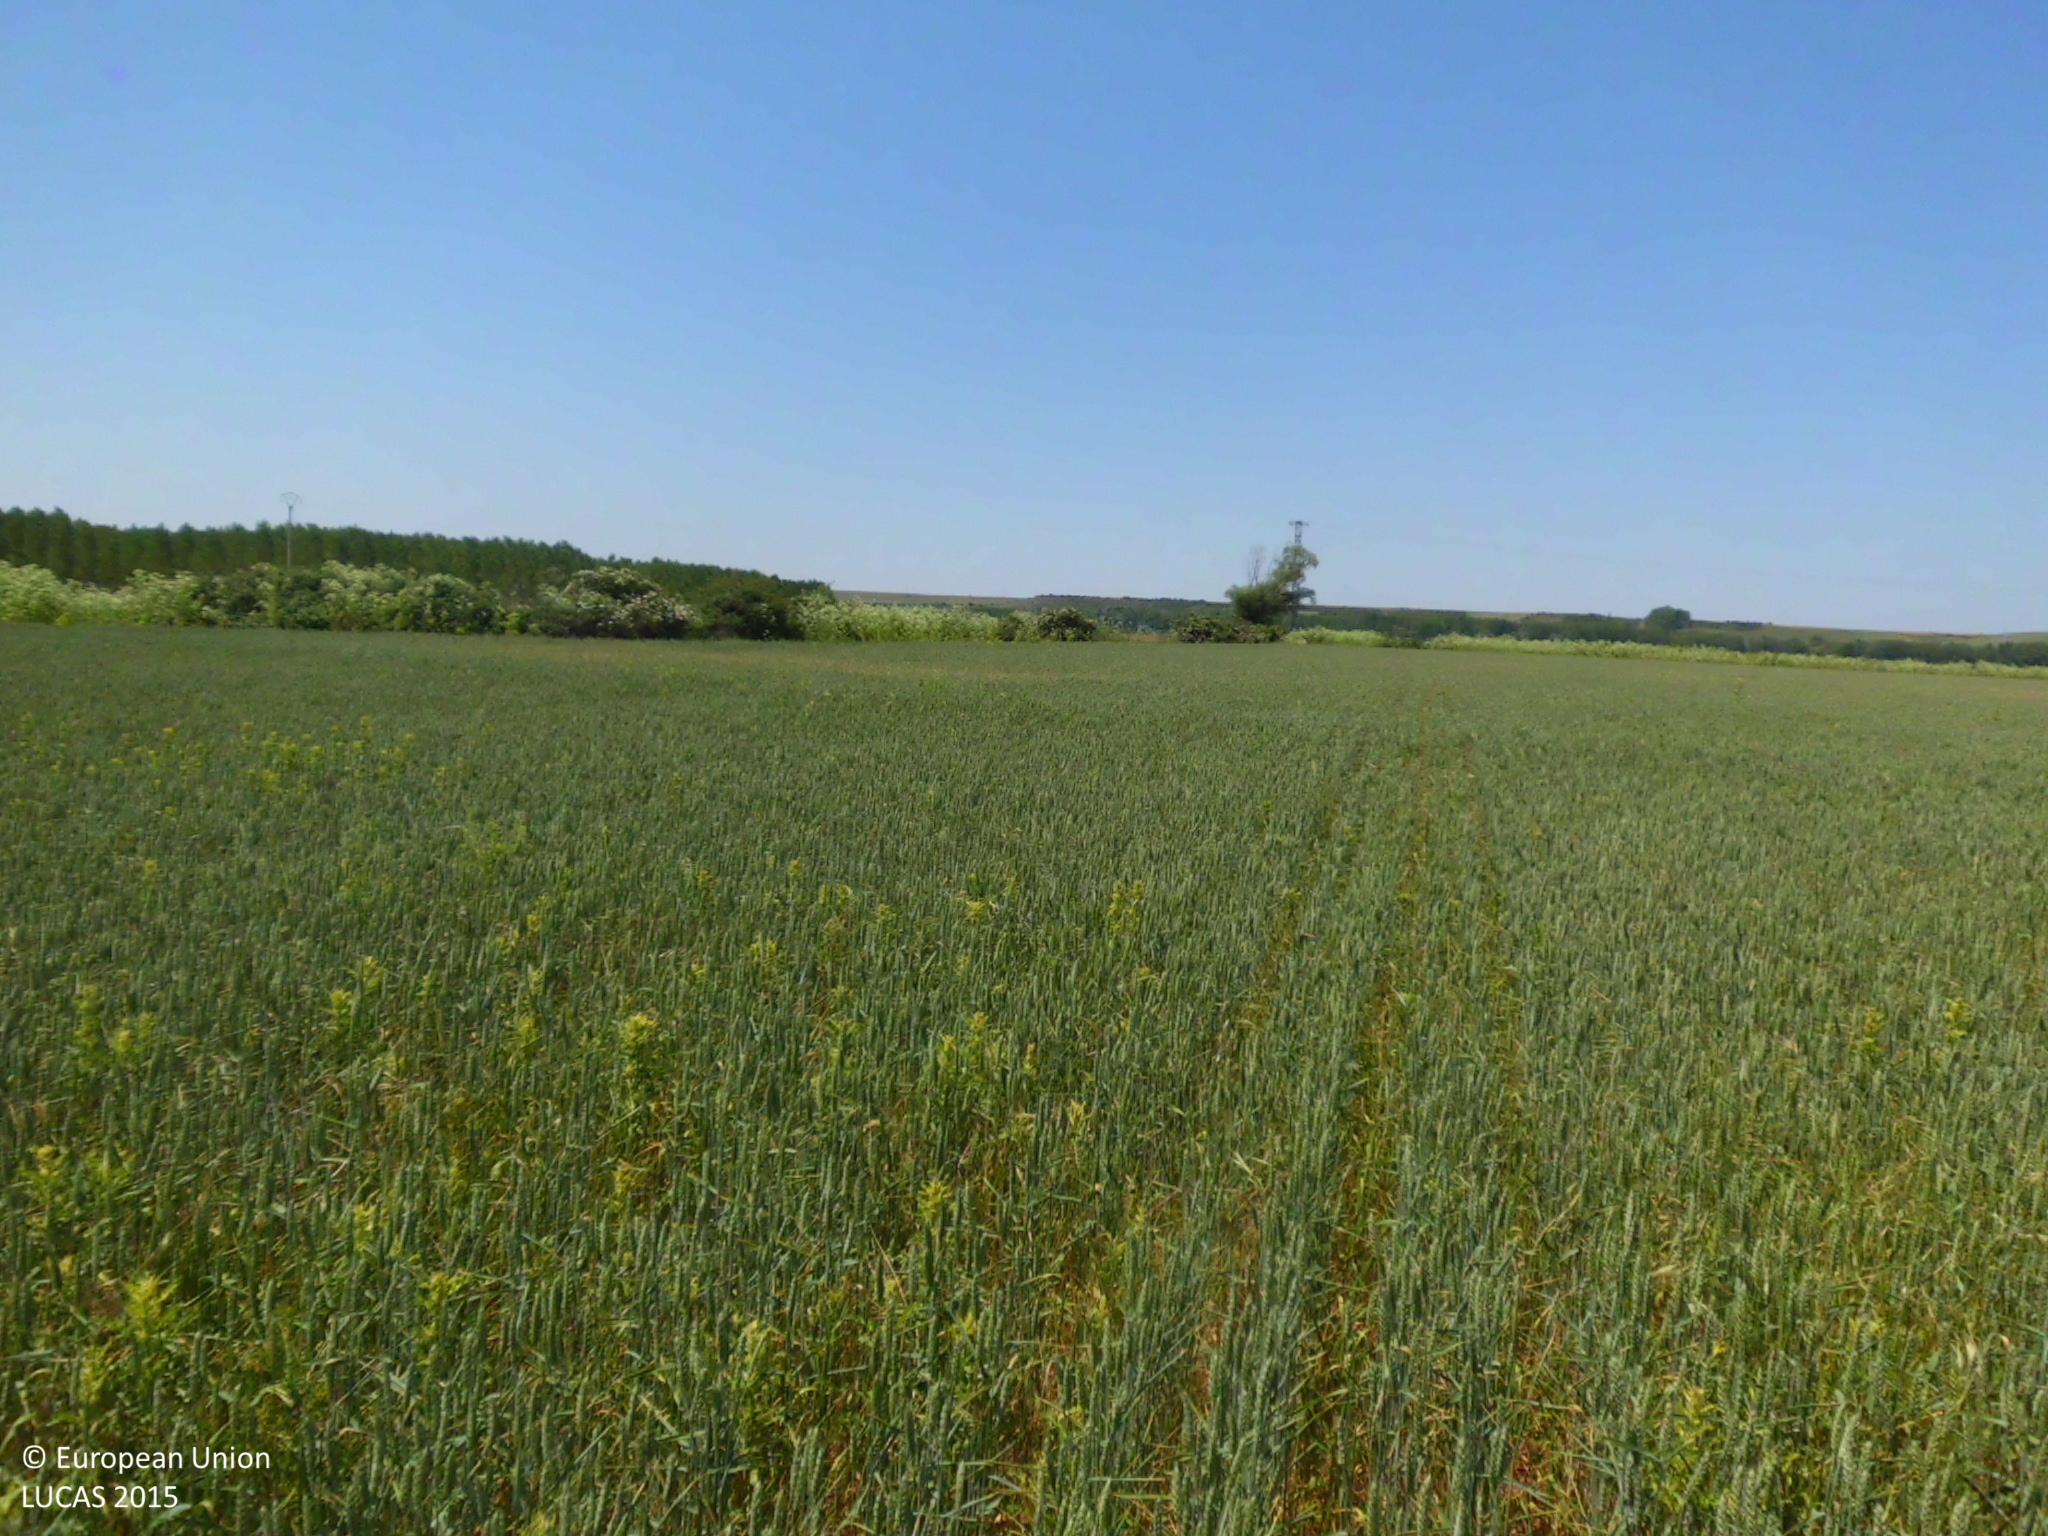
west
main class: Cropland
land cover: Common wheat
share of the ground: > 75 %
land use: Agriculture (excluding fallow land and kitchen gardens)
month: June
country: ES
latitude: 42.4273
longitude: -4.2546
